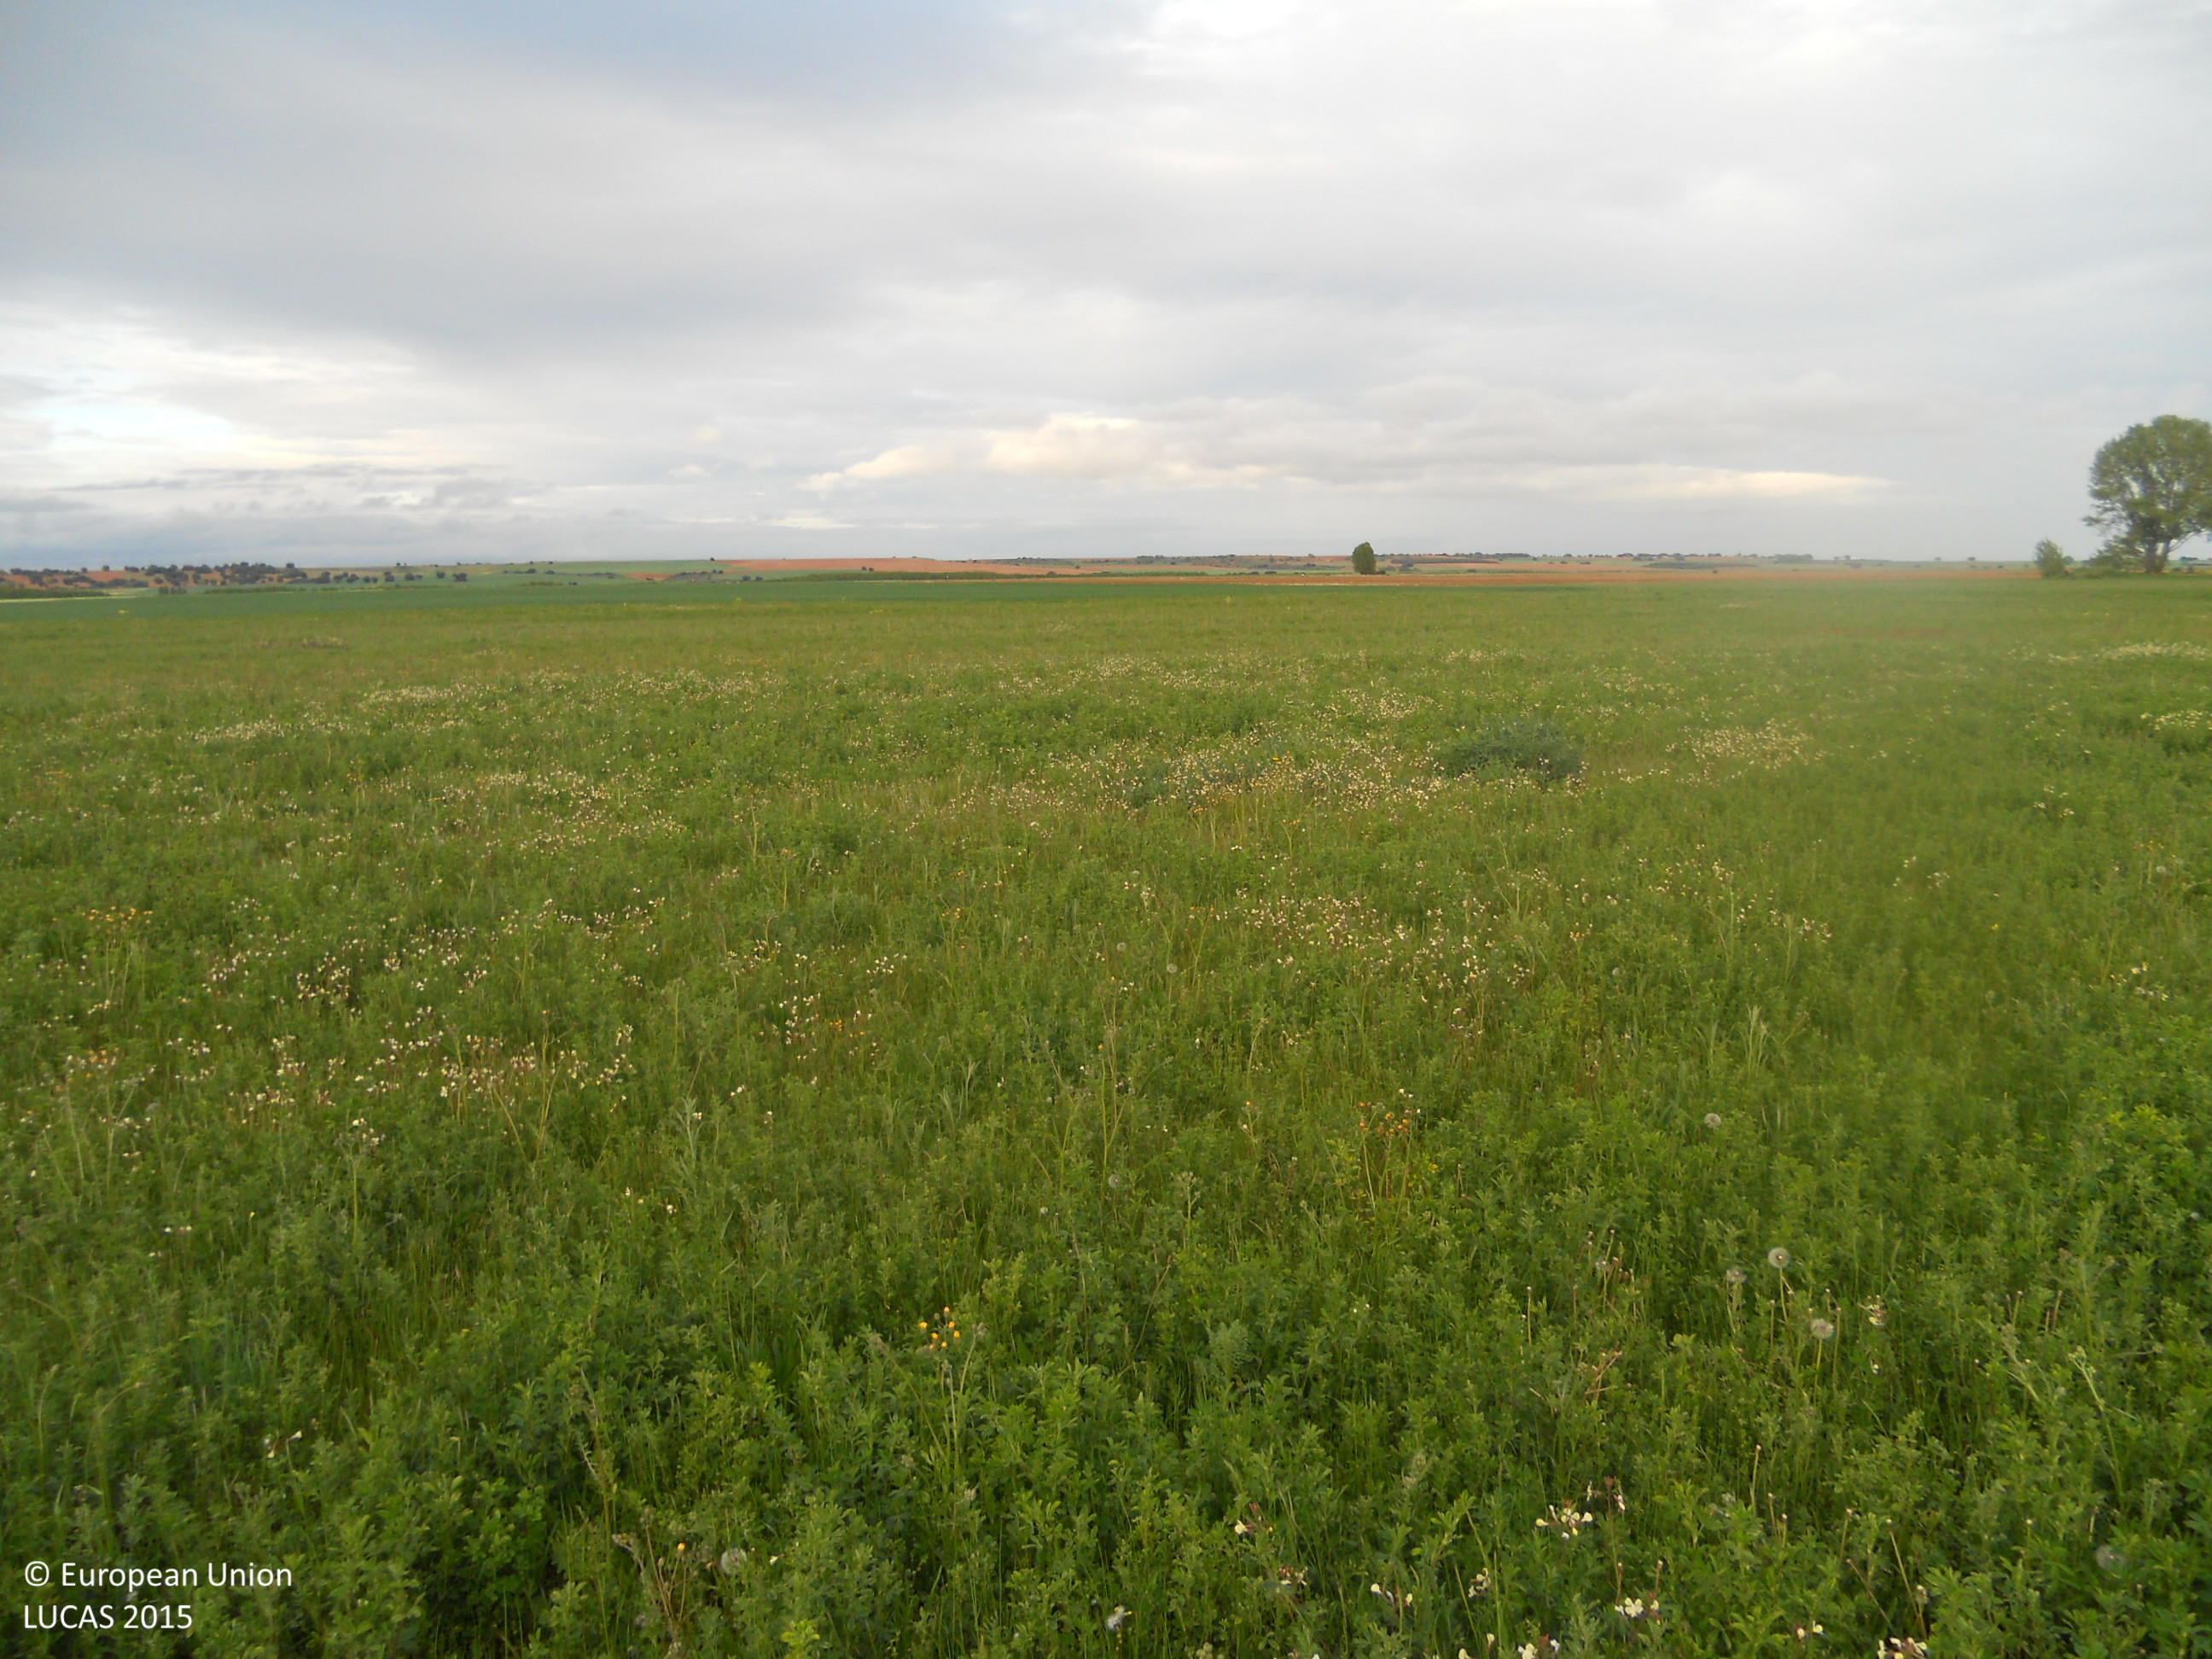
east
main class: Cropland
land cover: Lucerne
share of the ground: > 75 %
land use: Agriculture (excluding fallow land and kitchen gardens)
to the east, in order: Lucerne; Grass margins; Common wheat; Grass margins; Other bare soil
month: May
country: ES
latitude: 42.3109
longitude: -5.2893
